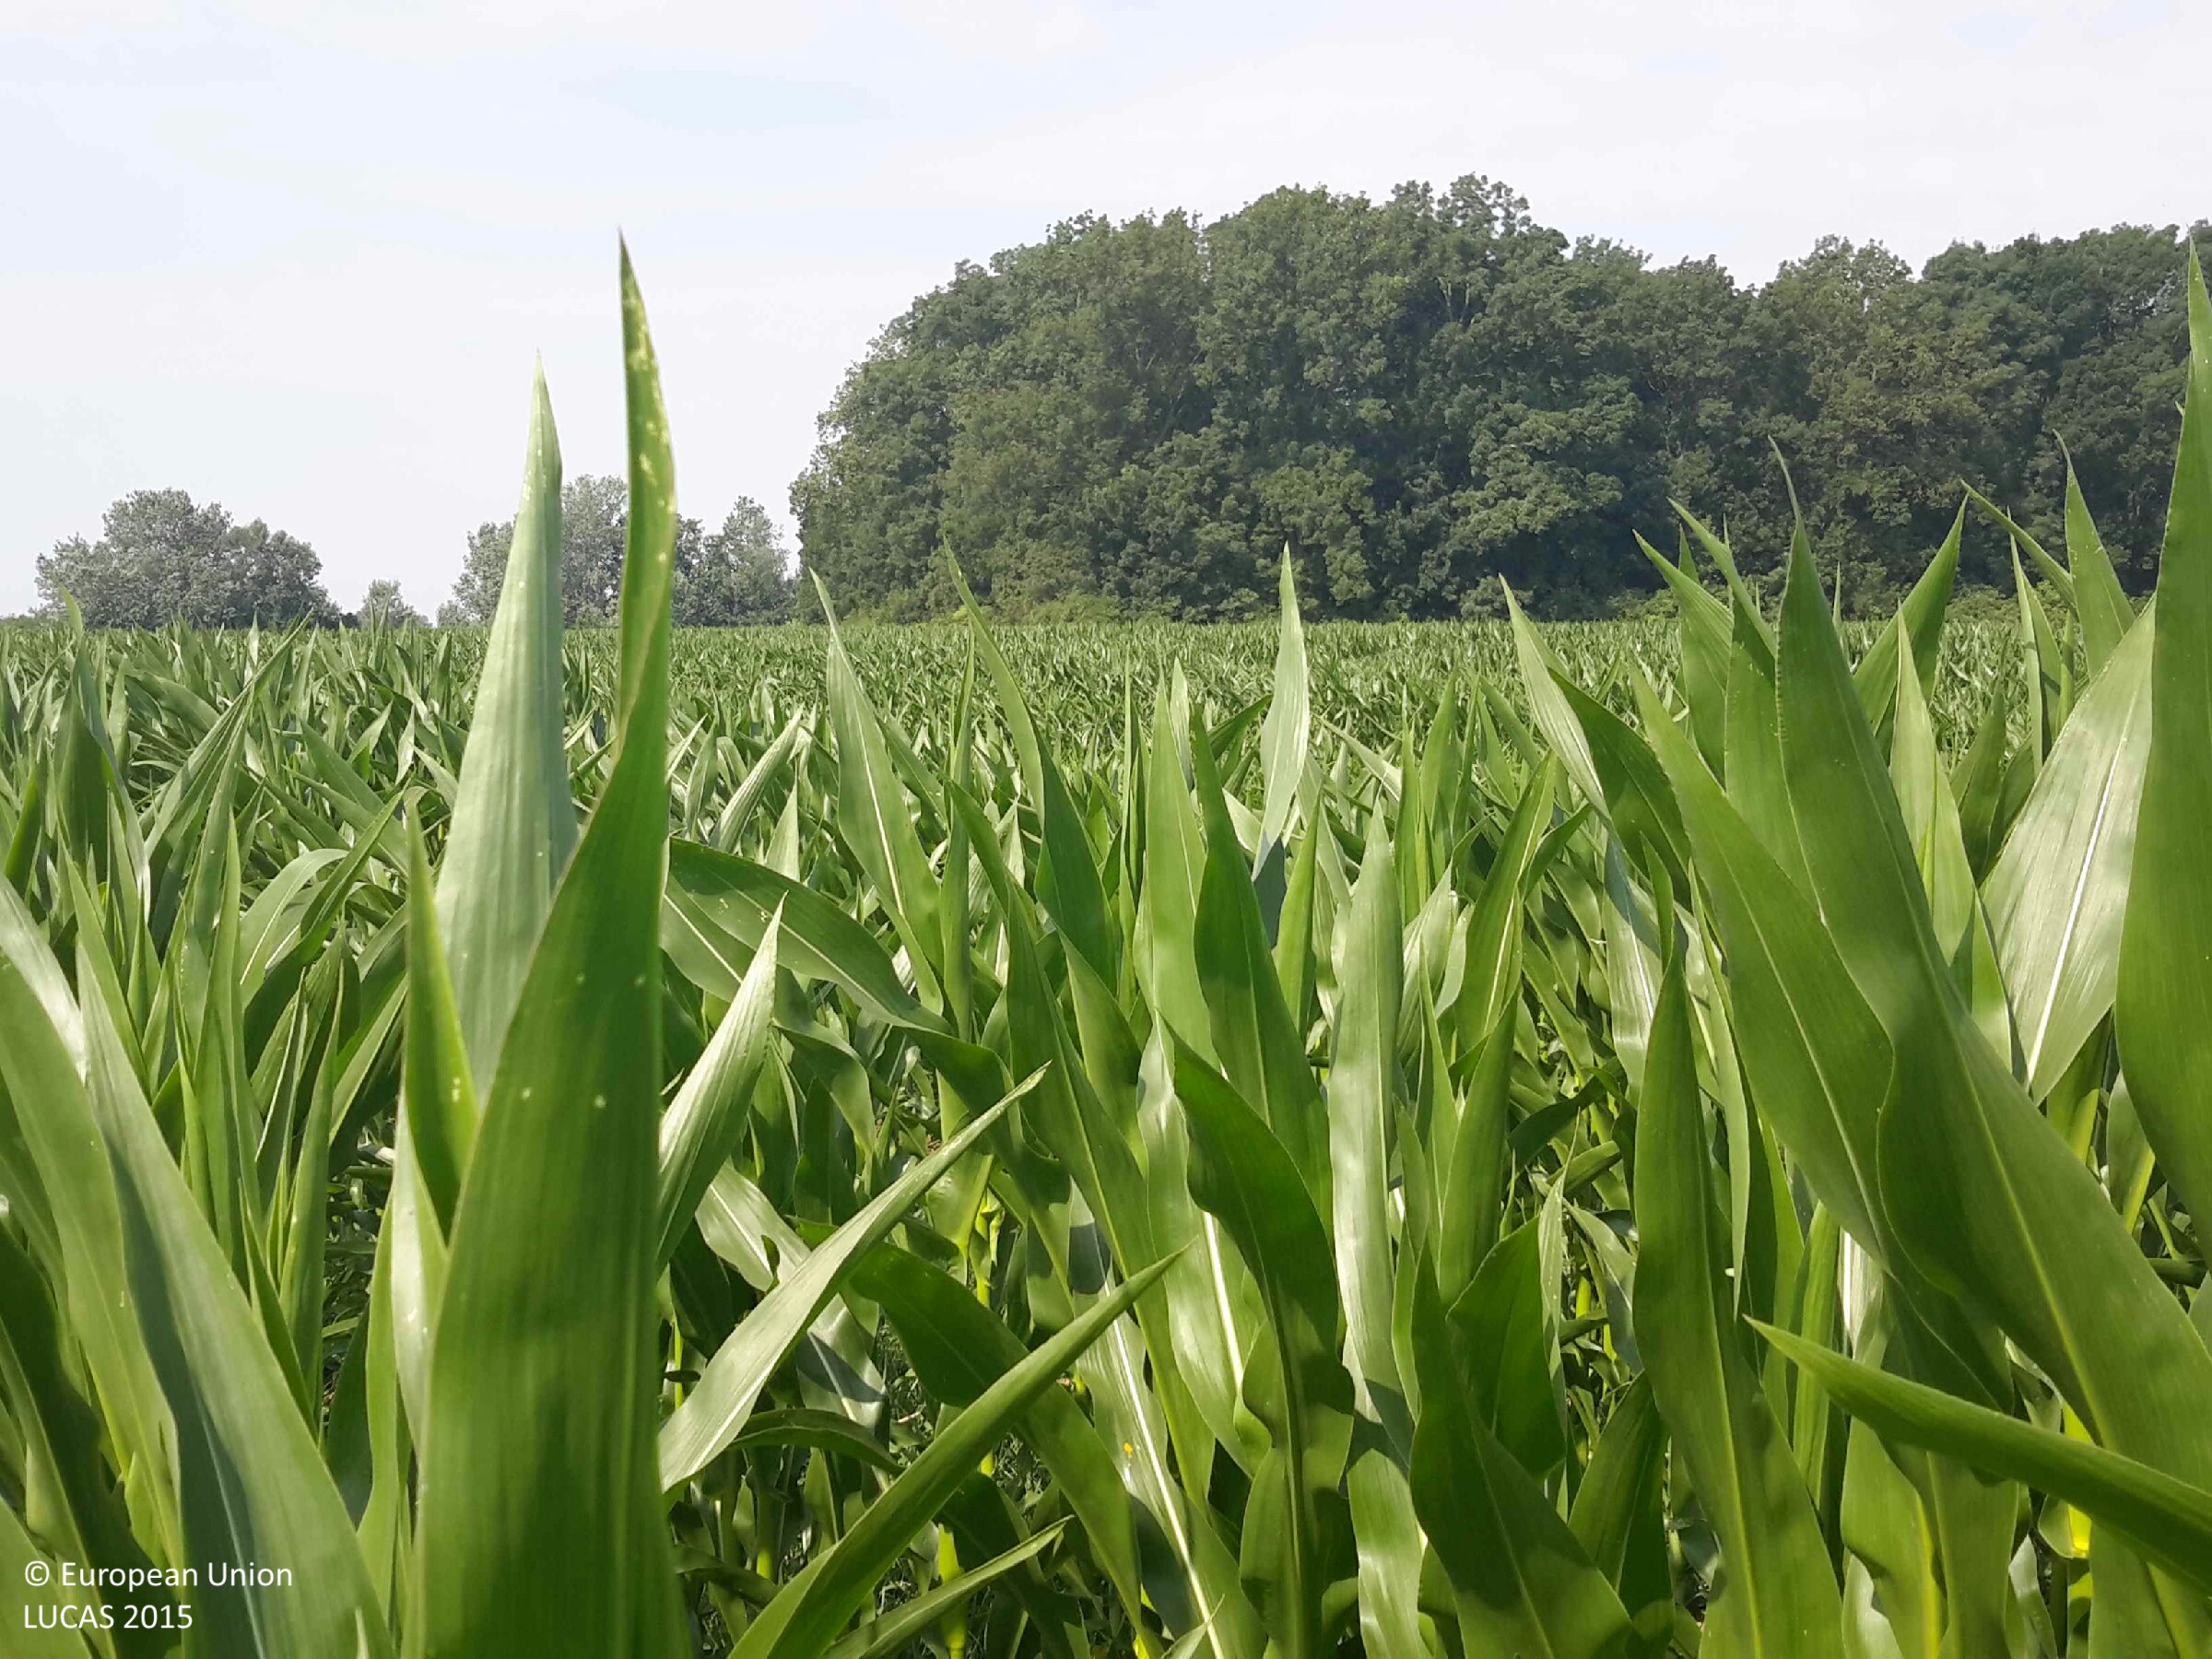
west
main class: Cropland
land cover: Maize
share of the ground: > 75 %
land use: Agriculture (excluding fallow land and kitchen gardens)
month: July
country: HU
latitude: 47.3955
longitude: 17.4135
